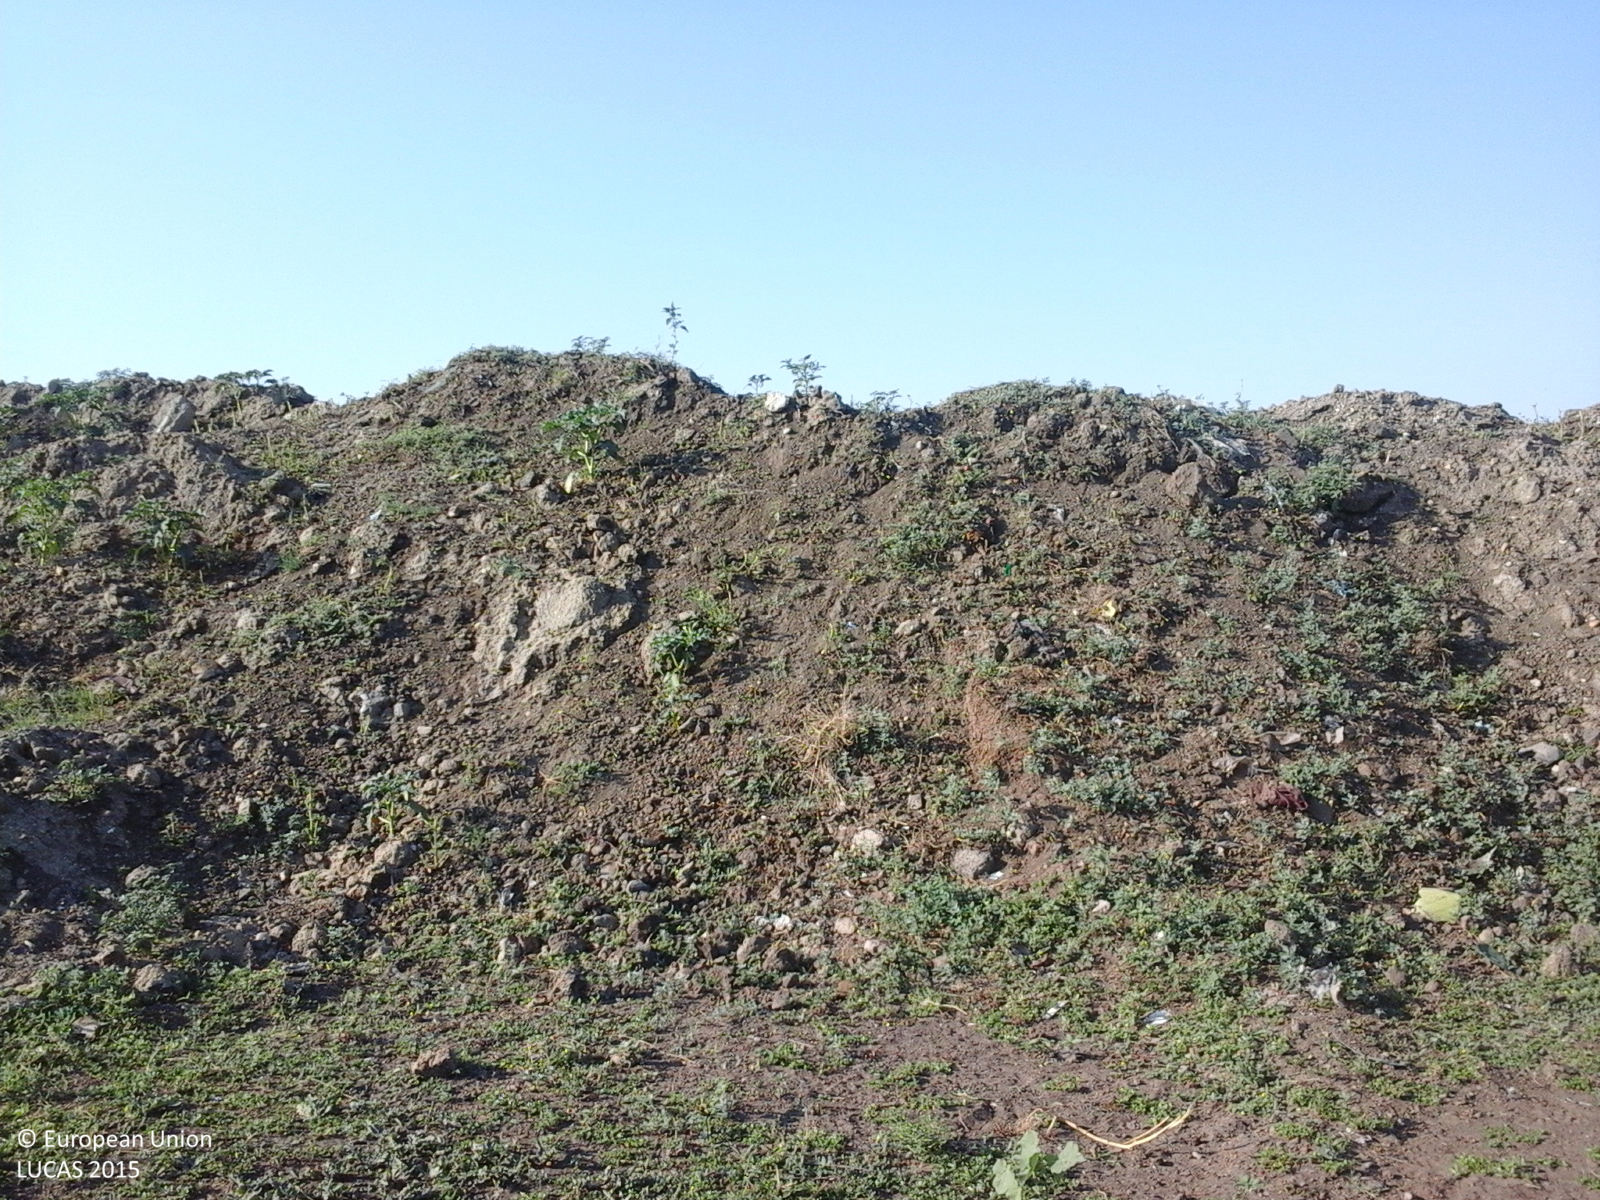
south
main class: Grassland
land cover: Spontaneously vegetated surfaces
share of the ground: 50 - 75 %
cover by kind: herbaceous plants 100 %
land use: Abandoned areas
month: August
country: RO
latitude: 44.0346
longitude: 23.1839
